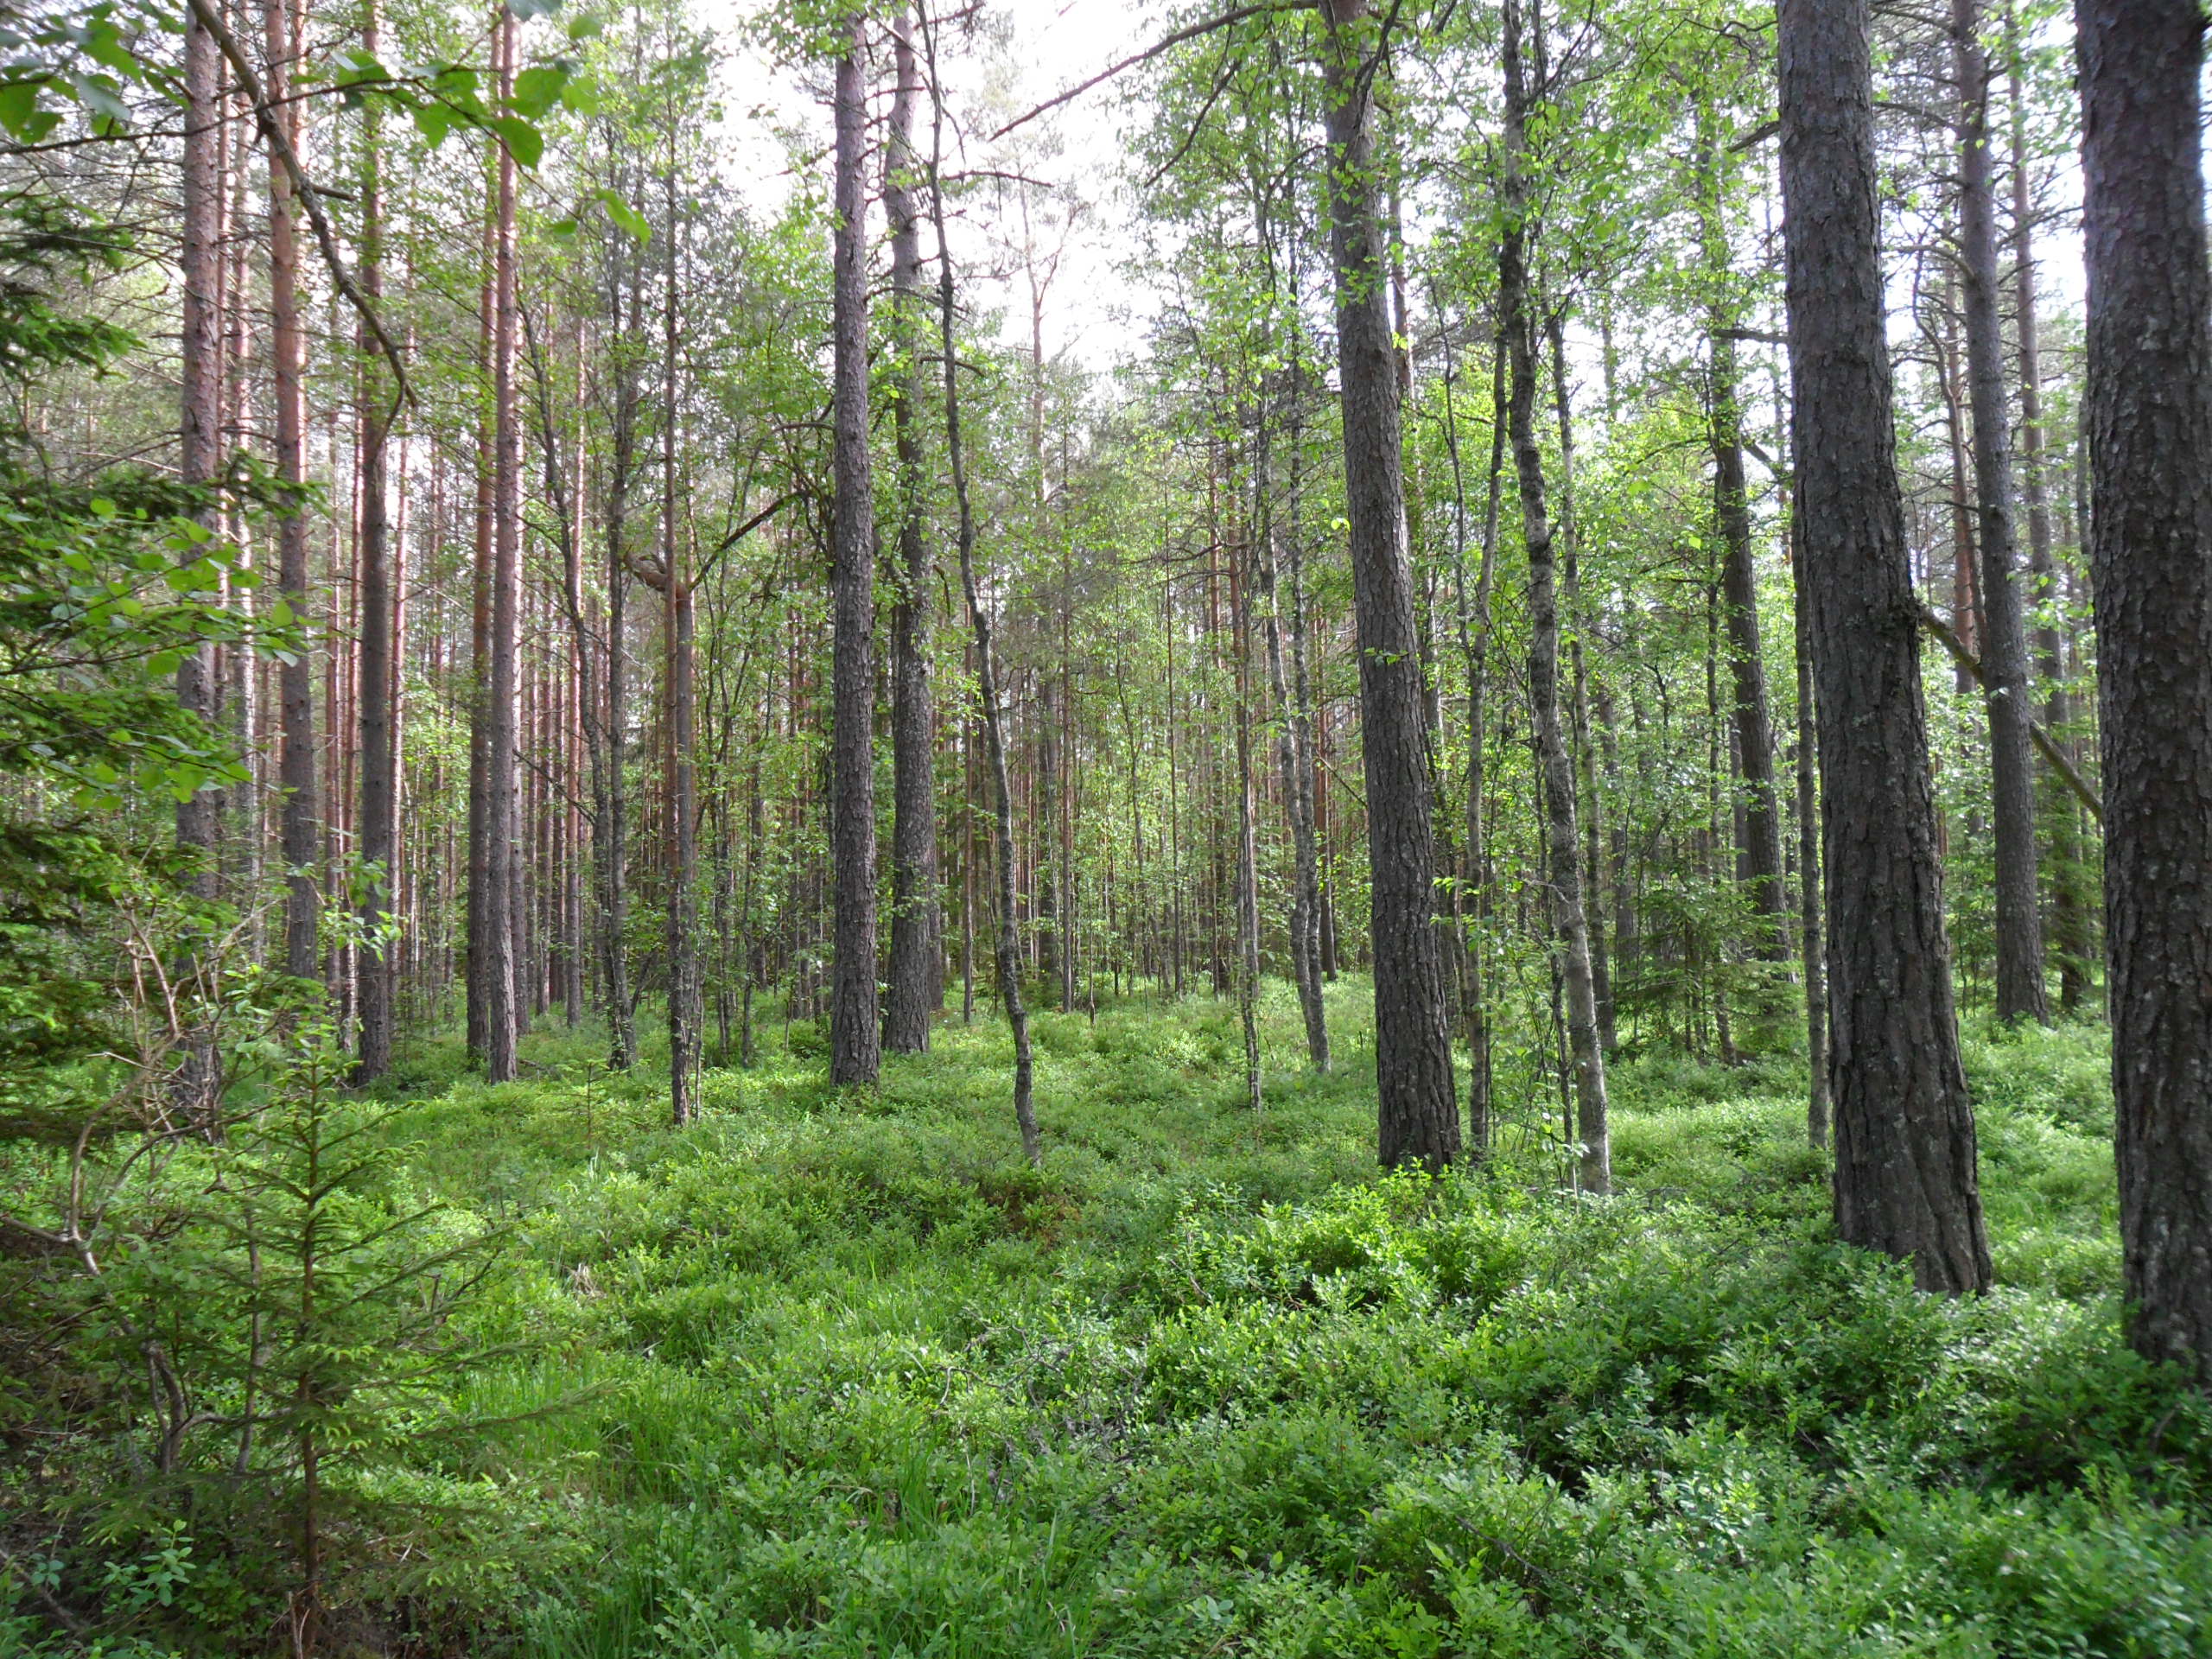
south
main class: Woodland
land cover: Pine dominated mixed woodland
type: hemiboreal forest and nemoral coniferous forest and mixed broadleaved-coniferous forest
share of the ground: 50 - 75 %
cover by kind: coniferous forest trees 45 %, broadleaved forest trees 25 %, herbaceous plants 15 %, lichens and mosses 10 %, shrubs 5 %
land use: Forestry
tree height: > 5 m
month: June
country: LV
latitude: 57.5918
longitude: 22.5498
